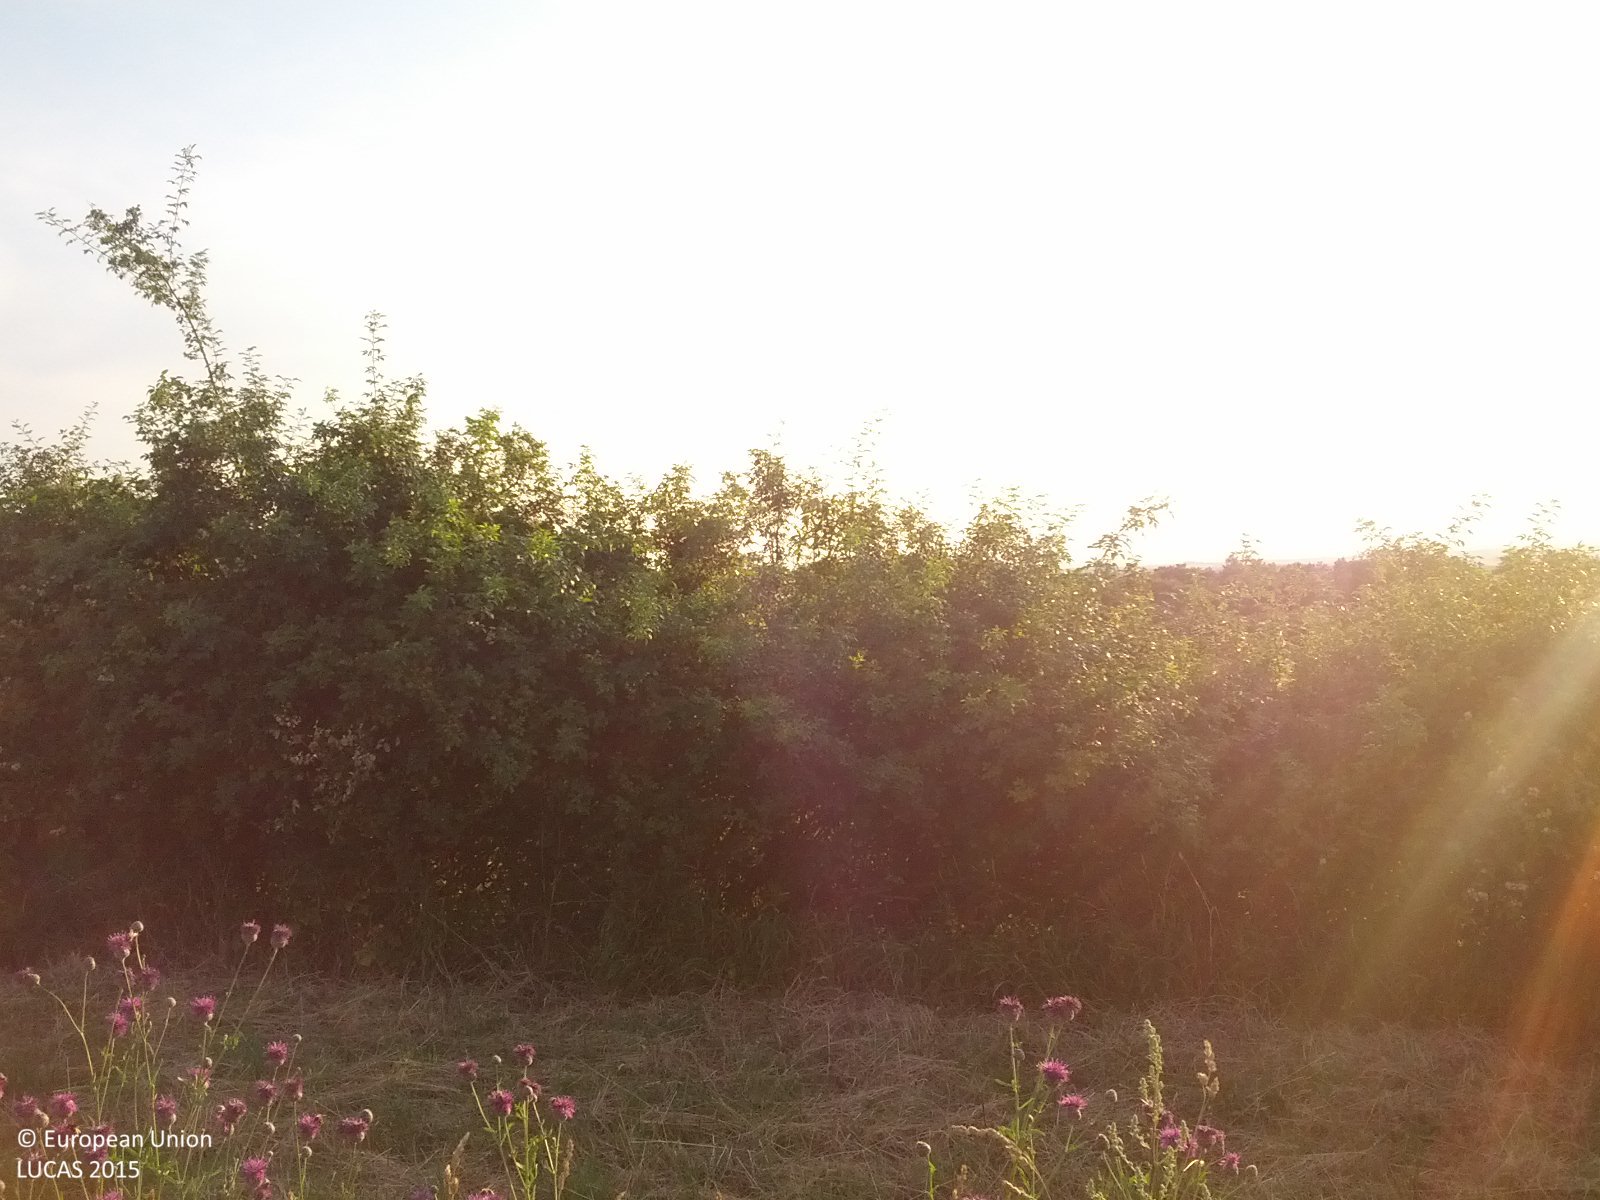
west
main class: Grassland
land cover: Grassland without tree/shrub cover
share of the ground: > 75 %
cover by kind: herbaceous plants 100 %
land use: Agriculture (excluding fallow land and kitchen gardens)
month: July
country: AT
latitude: 48.6216
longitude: 16.2865
